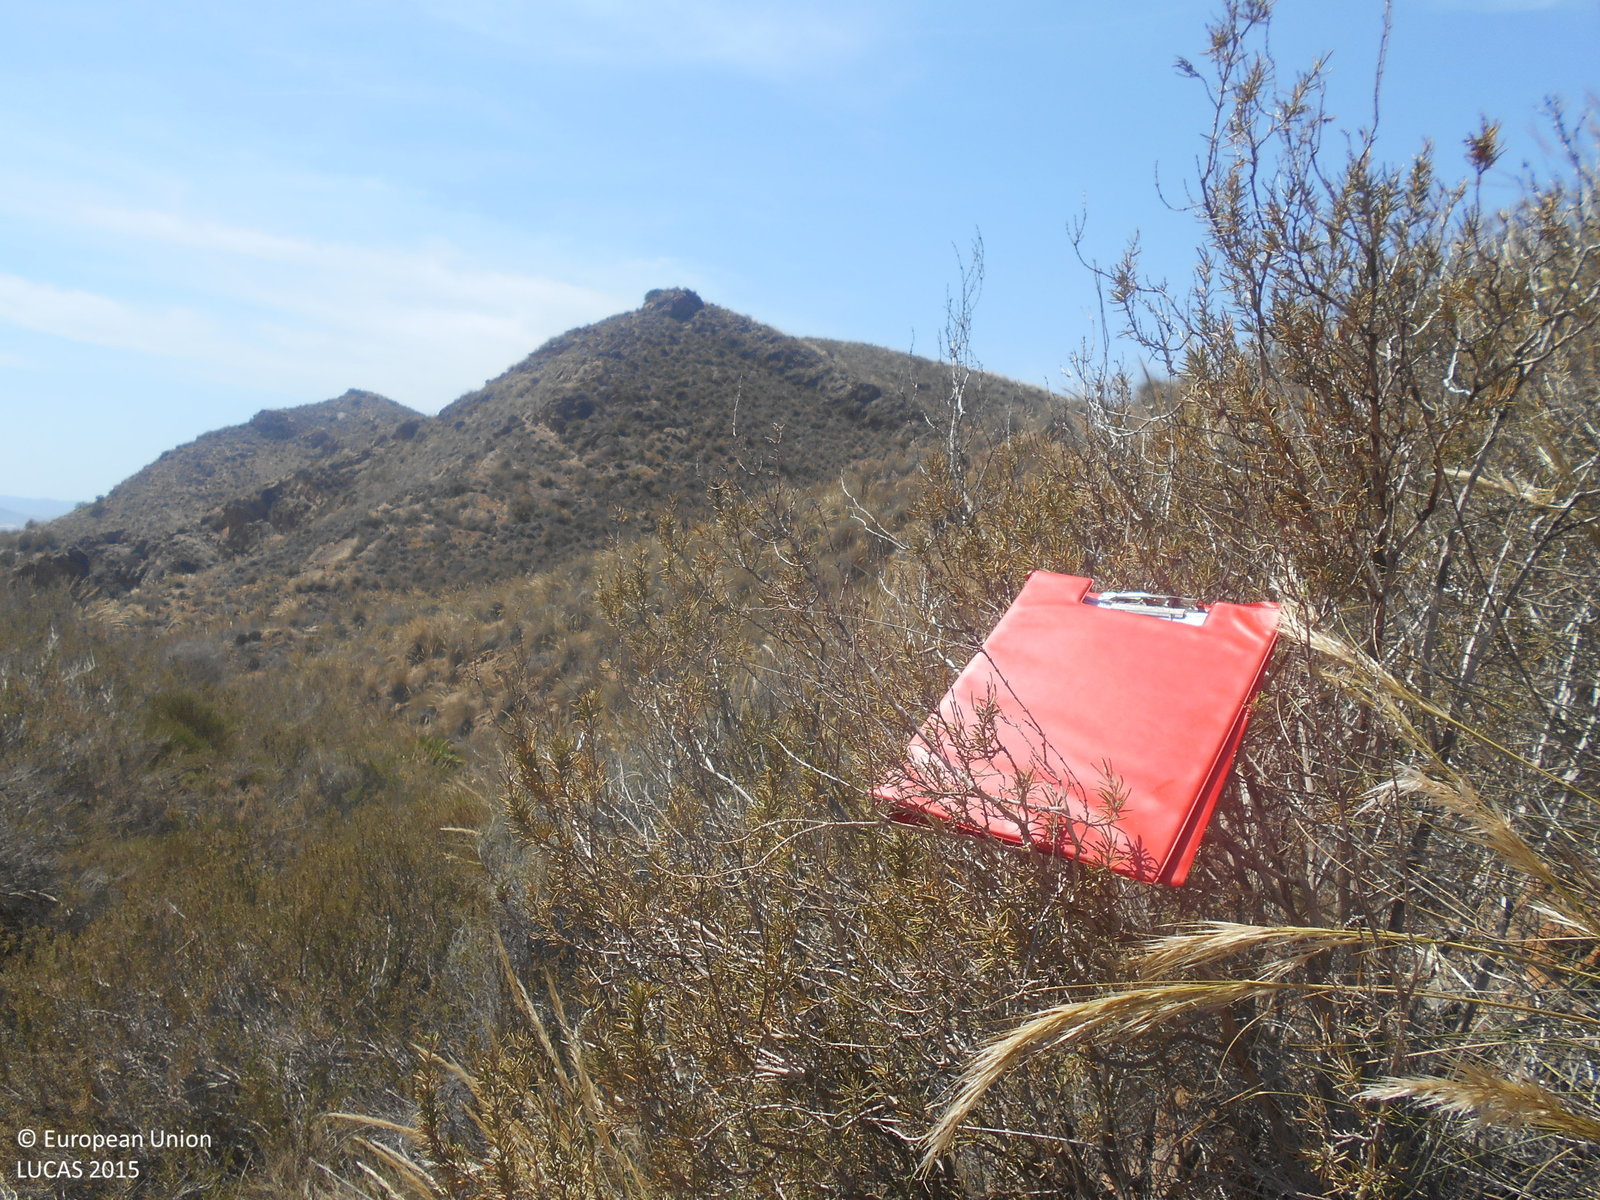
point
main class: Shrubland
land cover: Shrubland without tree cover
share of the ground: > 75 %
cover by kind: shrubs 90 %, unconsolidated bare surface 10 %
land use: Semi-natural and natural areas not in use
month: May
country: ES
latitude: 37.6387
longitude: -1.3014
